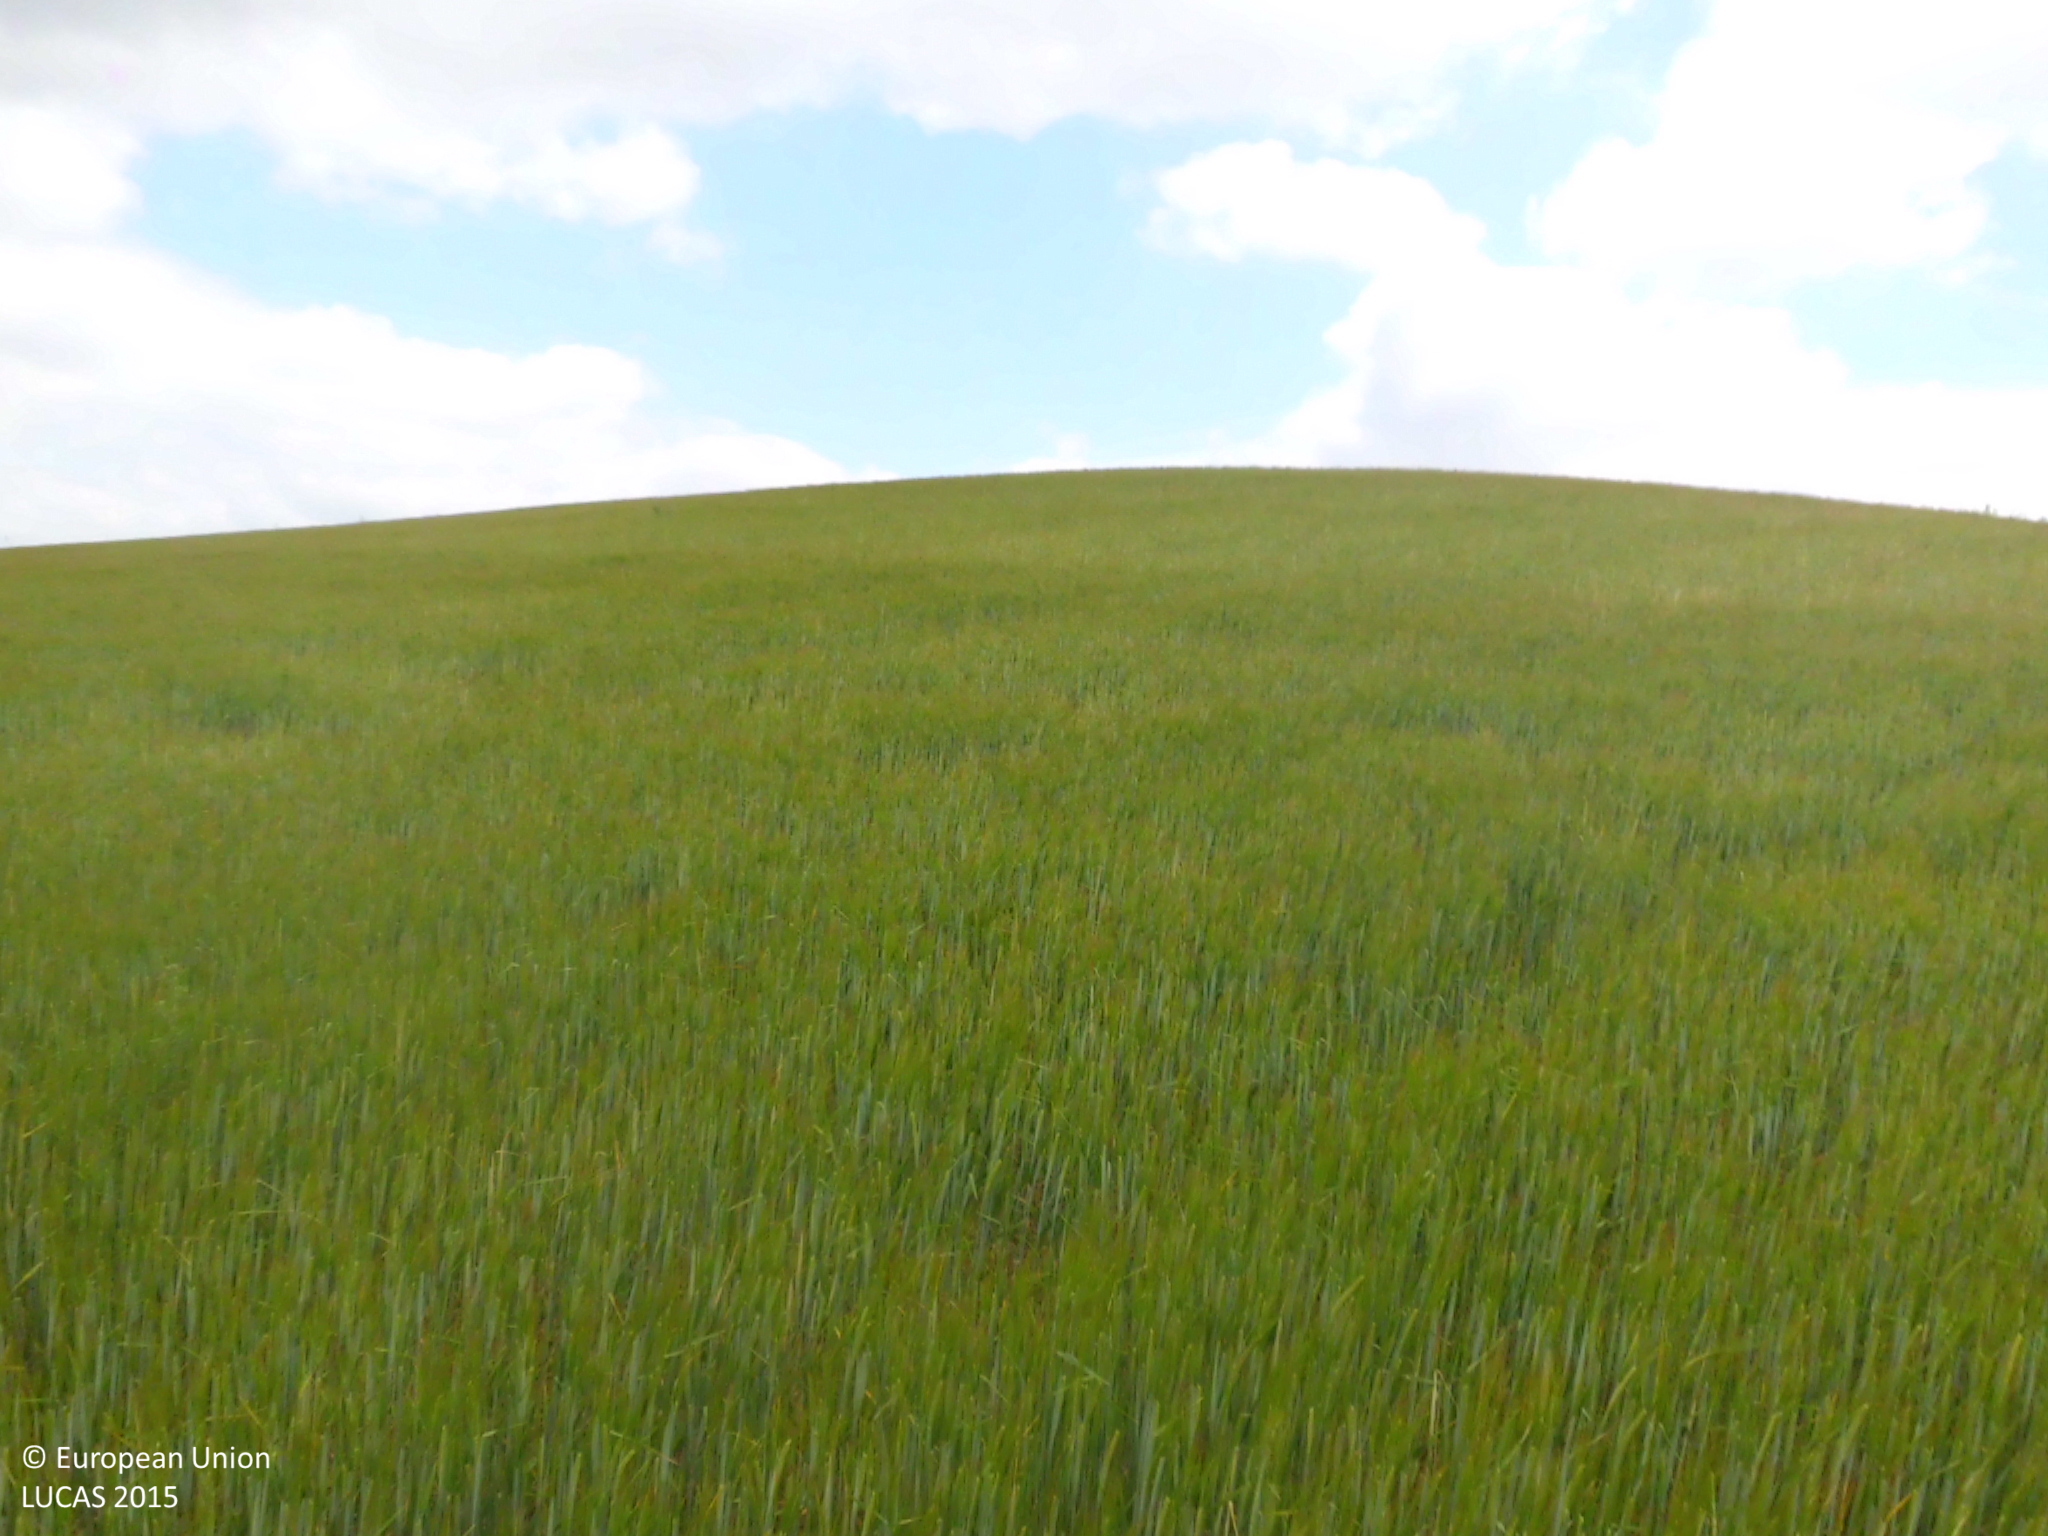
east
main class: Cropland
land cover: Barley
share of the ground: > 75 %
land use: Agriculture (excluding fallow land and kitchen gardens)
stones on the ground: < 10 %
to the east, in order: Barley; Common wheat
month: June
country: ES
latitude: 42.5203
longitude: -3.3125
